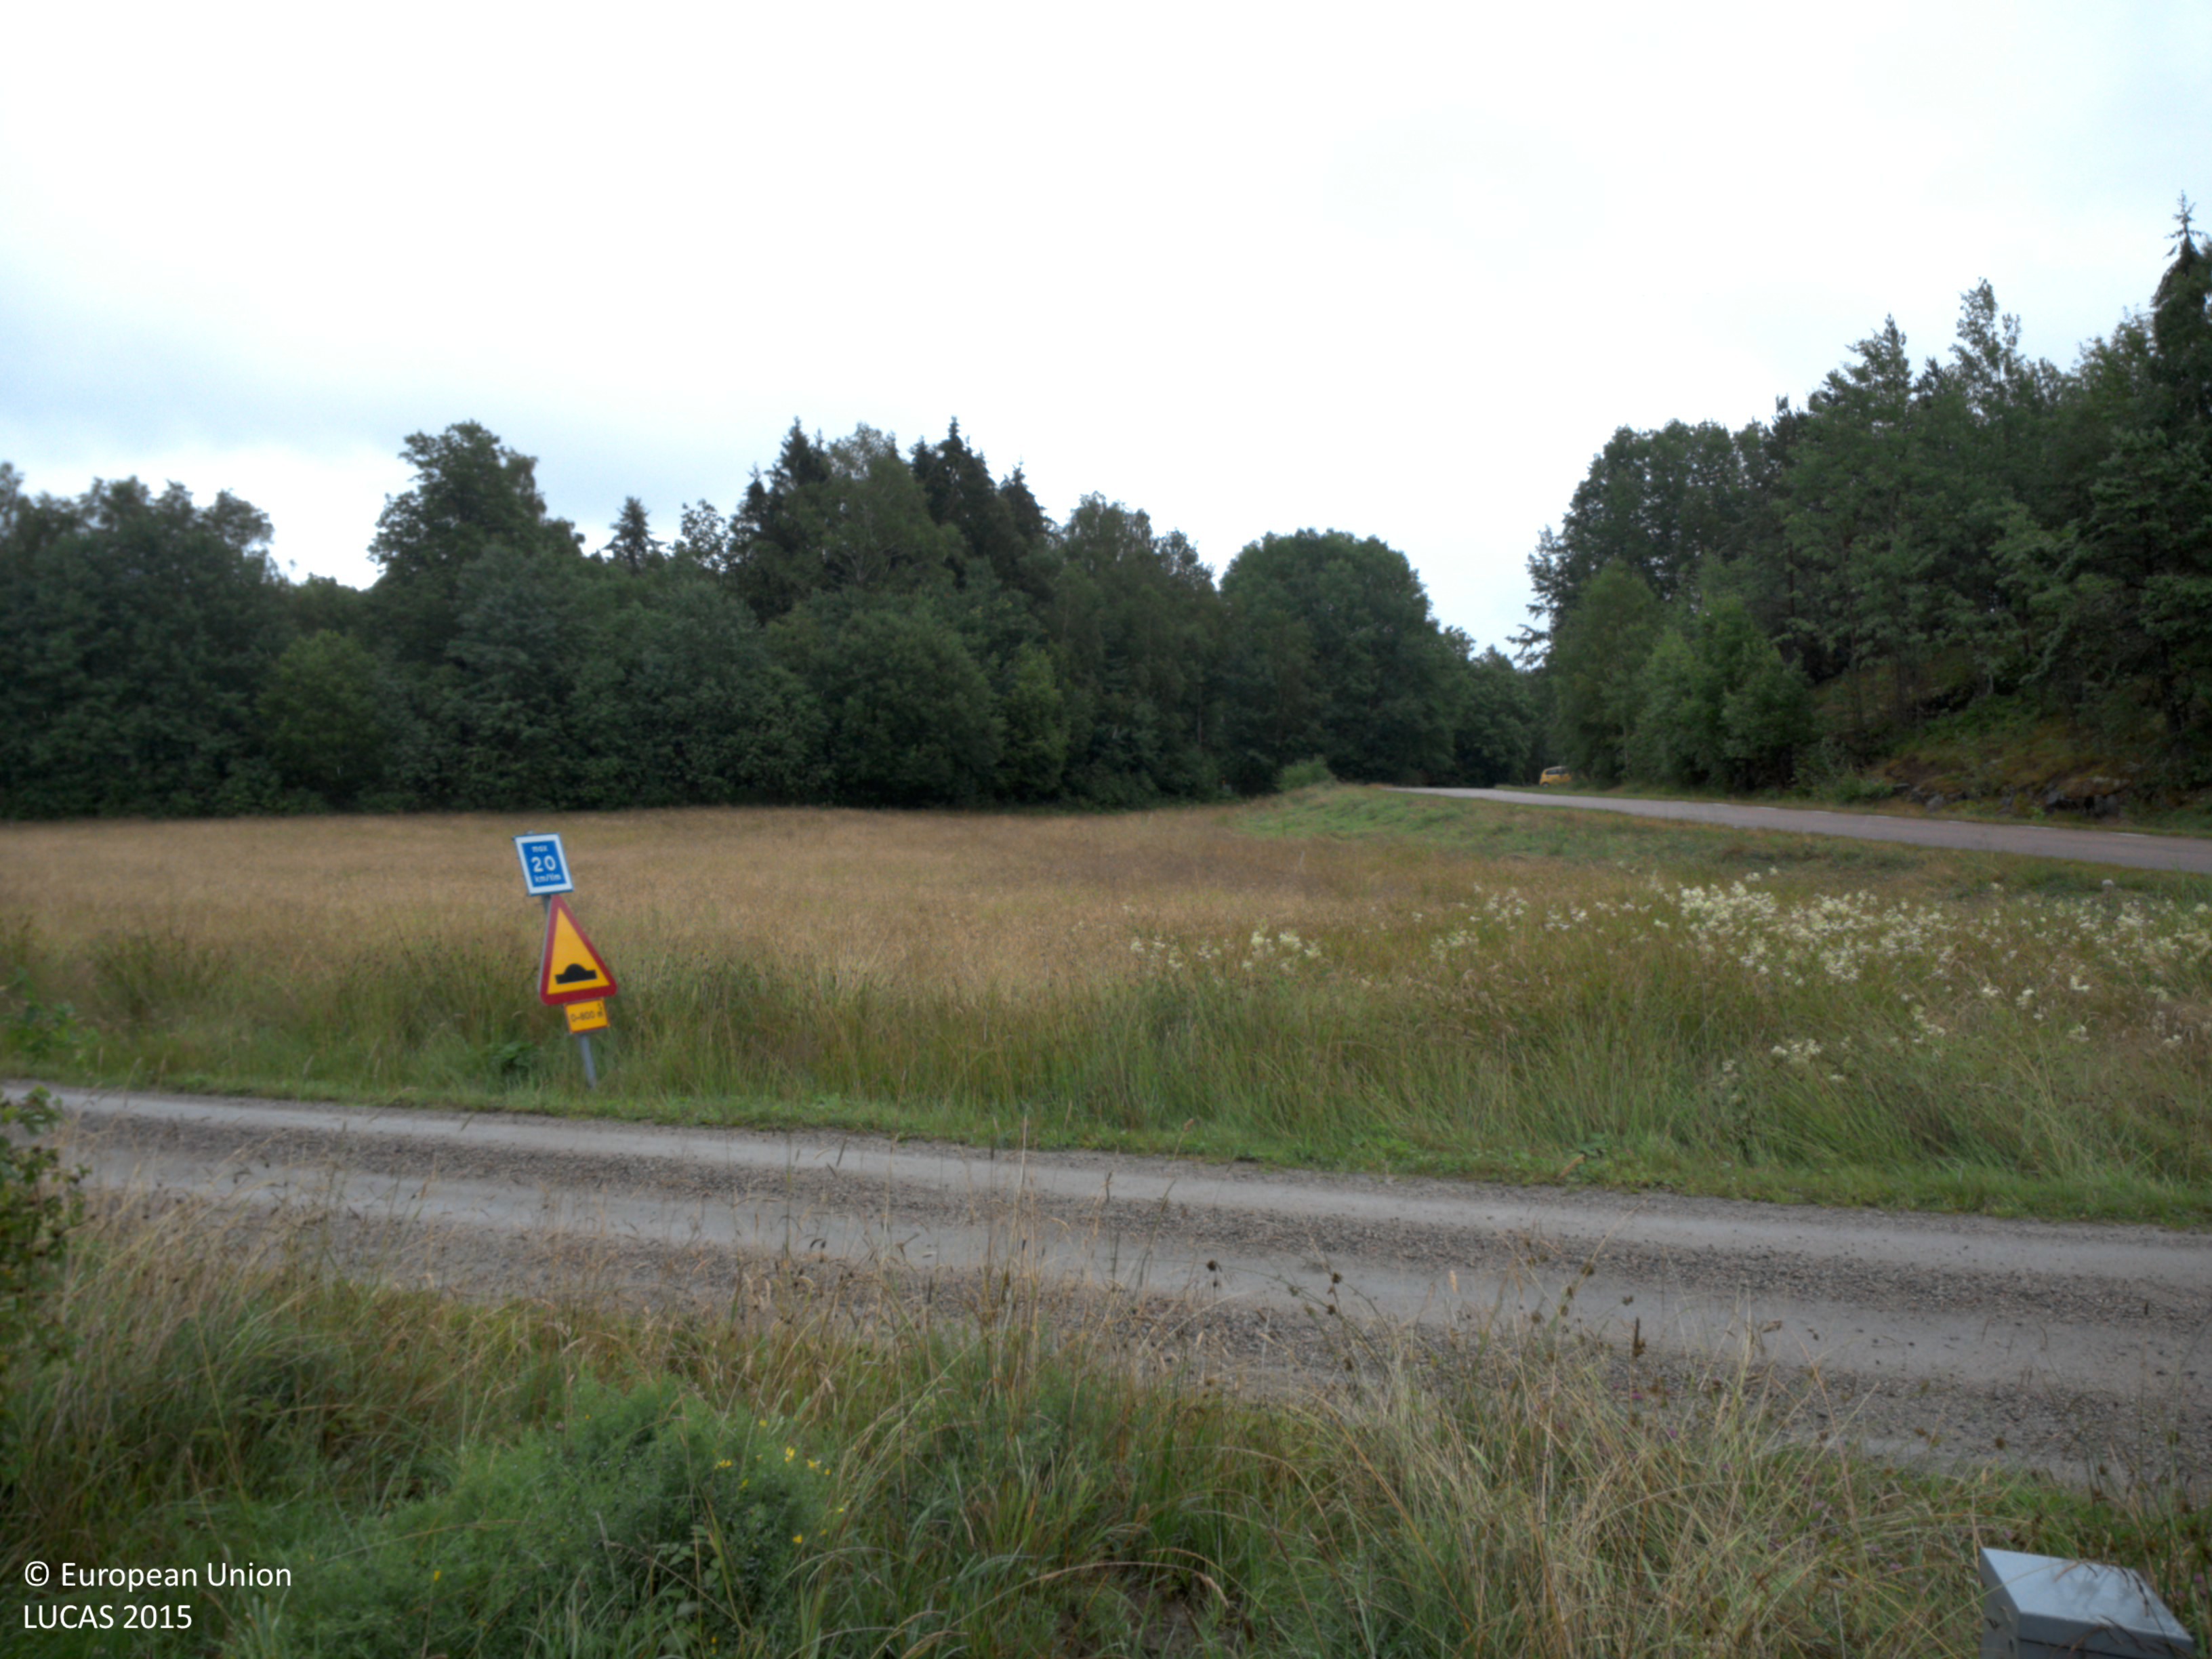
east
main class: Grassland
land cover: Grassland without tree/shrub cover
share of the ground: > 75 %
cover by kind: herbaceous plants 95 %, shrubs 5 %
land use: Abandoned areas
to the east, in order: Grassland without tree/shrub cover; Ditches and canals; Paved roads, cycling and walking lanes; Ditches and canals; Grassland with sparse tree/shrub cover; Grassland without tree/shrub cover; Broadleaved woodland; Spruce dominated mixed woodland; Broadleaved woodland; Spruce dominated mixed woodland; Artificial constructions in urban areas; Spruce dominated mixed woodland
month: July
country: SE
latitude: 58.2947
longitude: 11.9921
